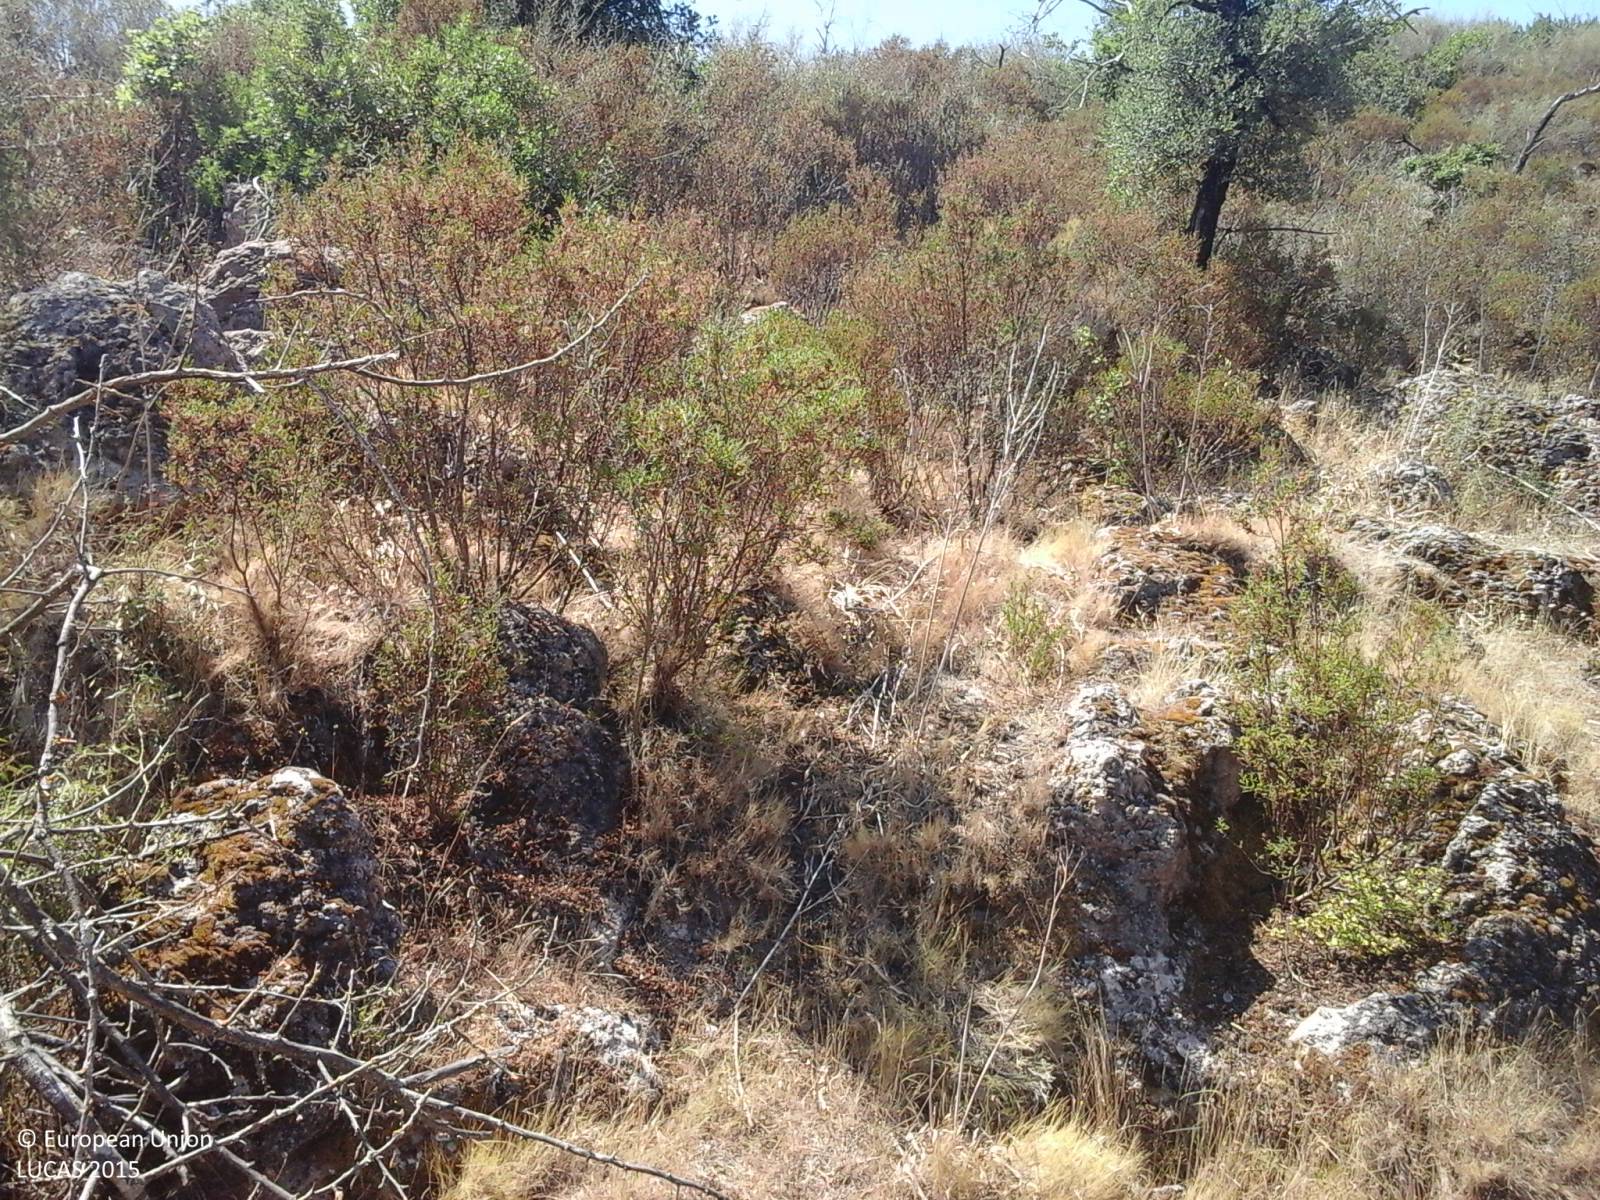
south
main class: Grassland
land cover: Grassland with sparse tree/shrub cover
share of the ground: 25 - 50 %
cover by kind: herbaceous plants 85 %, shrubs 10 %, broadleaved forest trees 5 %
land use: Agriculture (excluding fallow land and kitchen gardens)
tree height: < 5 m
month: July
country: IT
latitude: 40.5144
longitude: 8.8844
